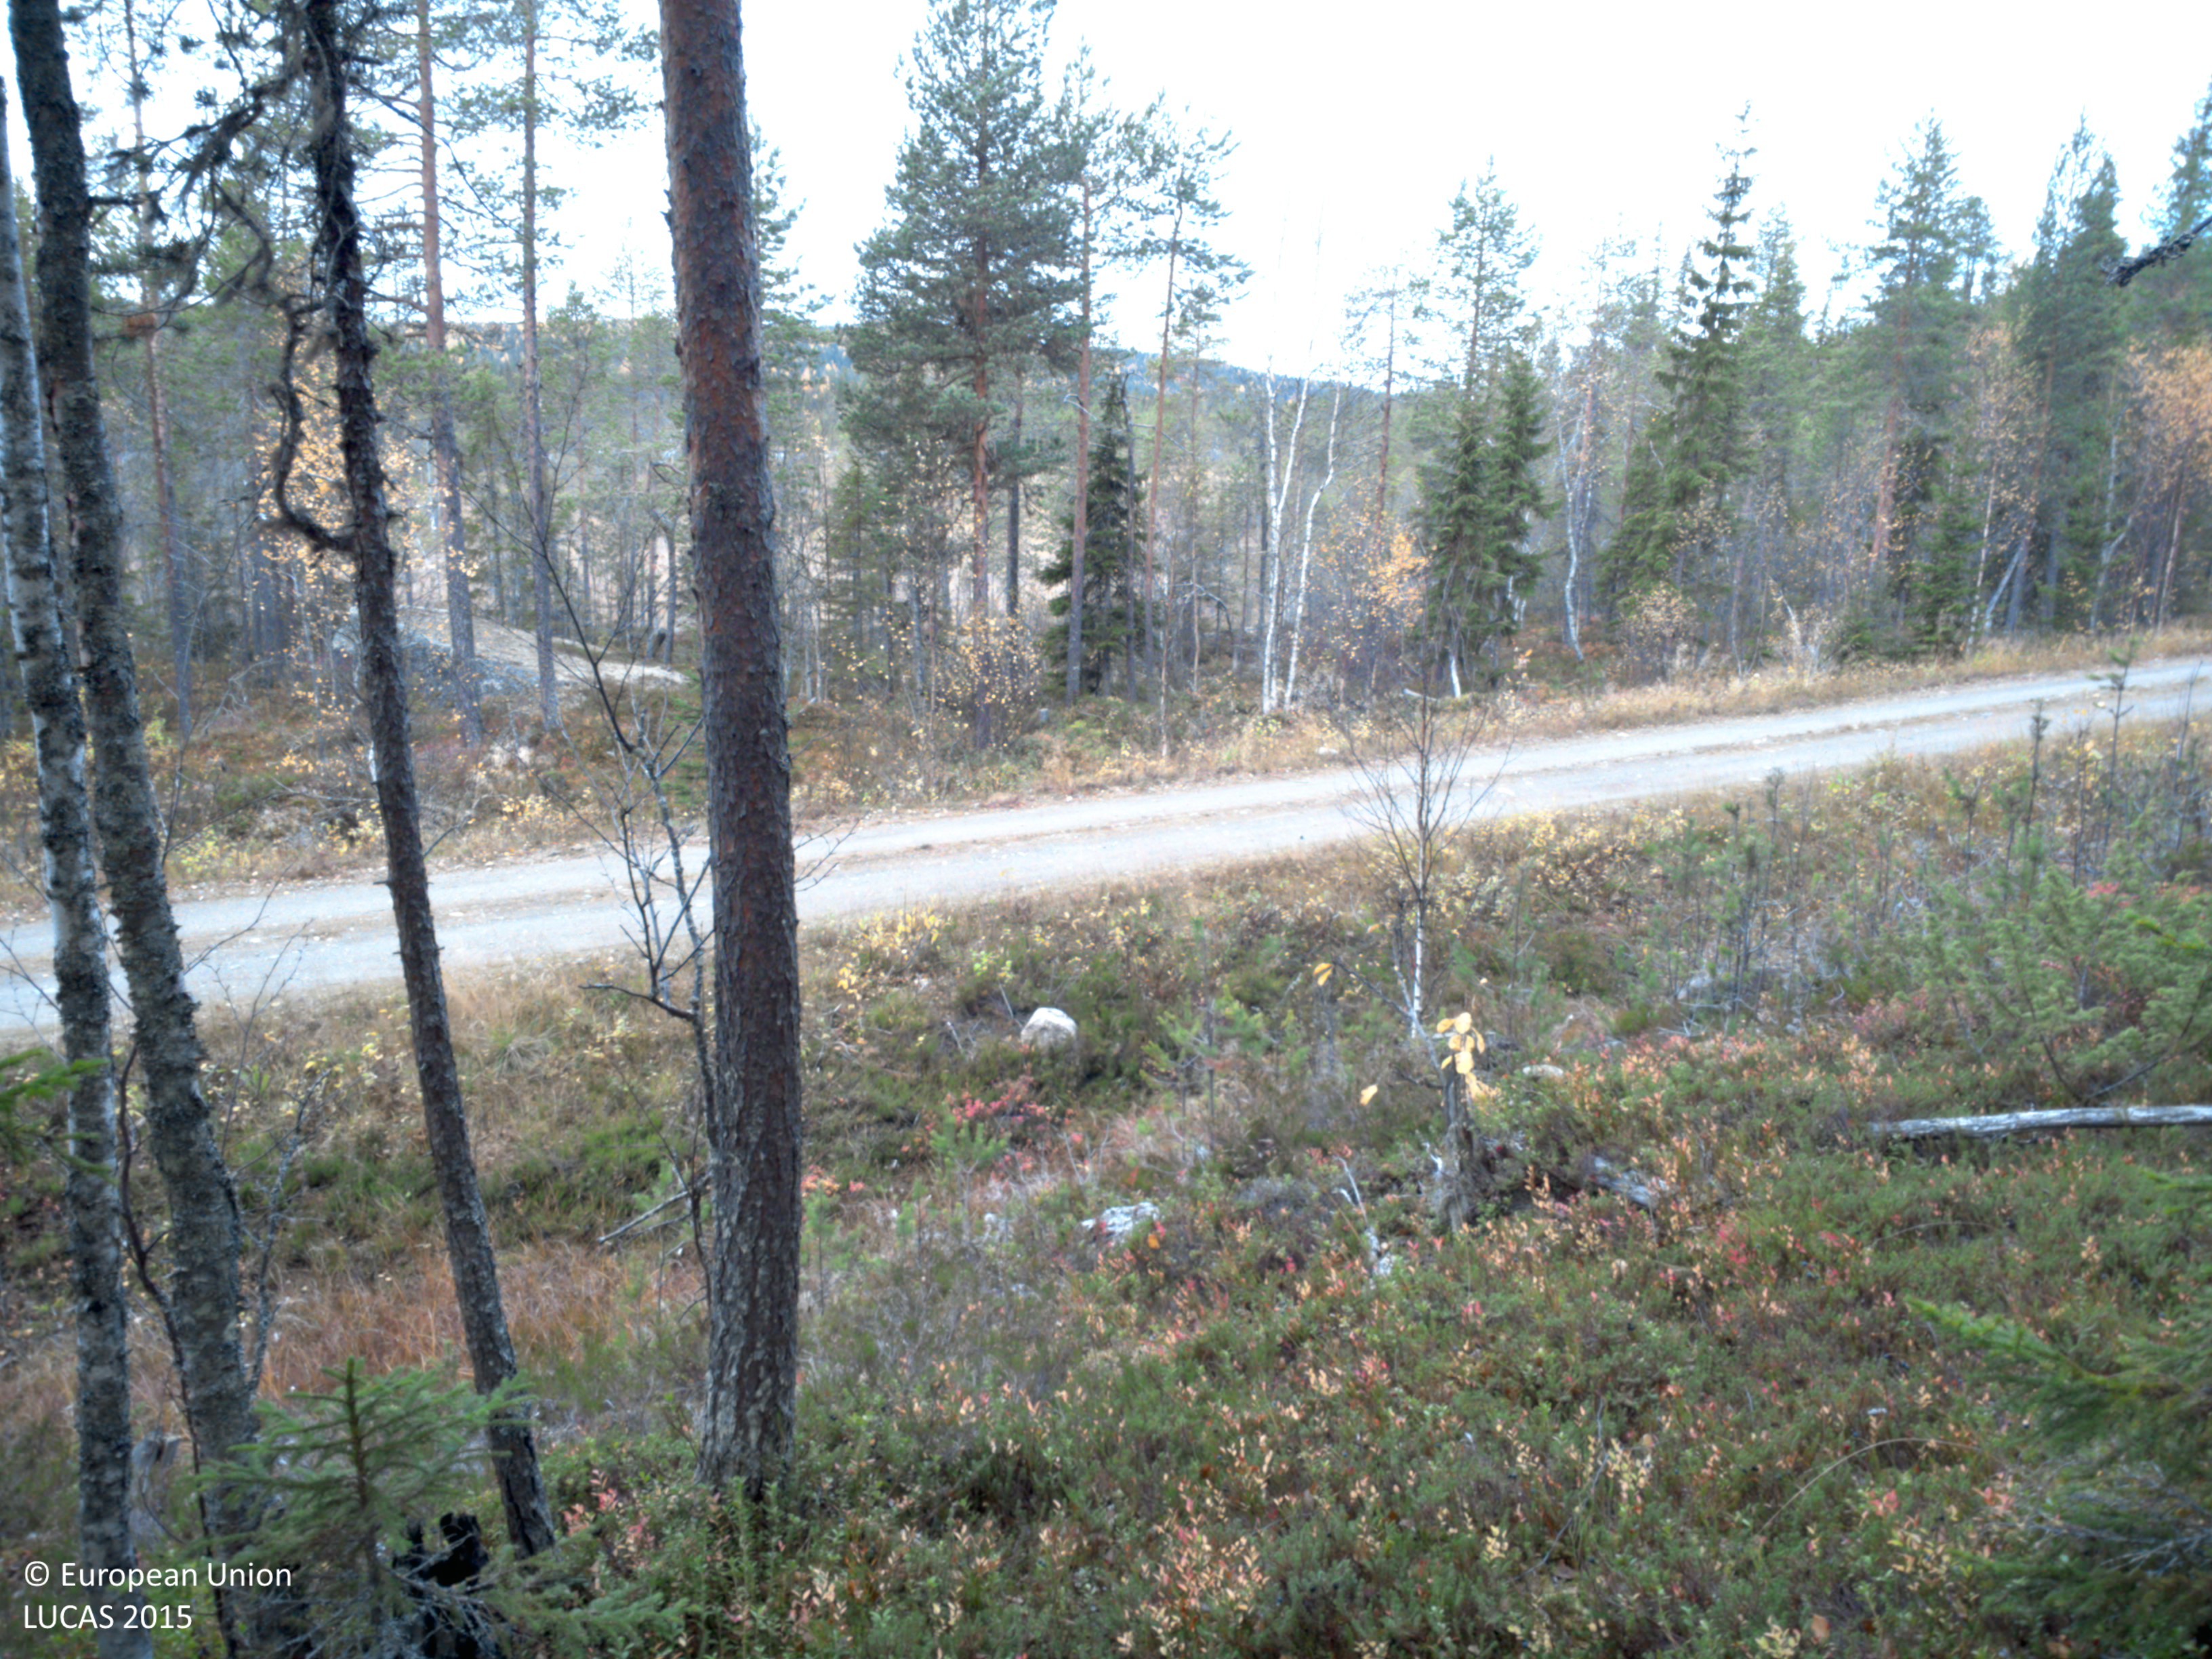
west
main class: Woodland
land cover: Pine dominated coniferous woodland
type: boreal forest
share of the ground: 50 - 75 %
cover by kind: coniferous forest trees 70 %, shrubs 20 %, herbaceous plants 5 %, lichens and mosses 5 %
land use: Forestry
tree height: > 5 m
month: October
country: SE
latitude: 64.6987
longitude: 18.1238
